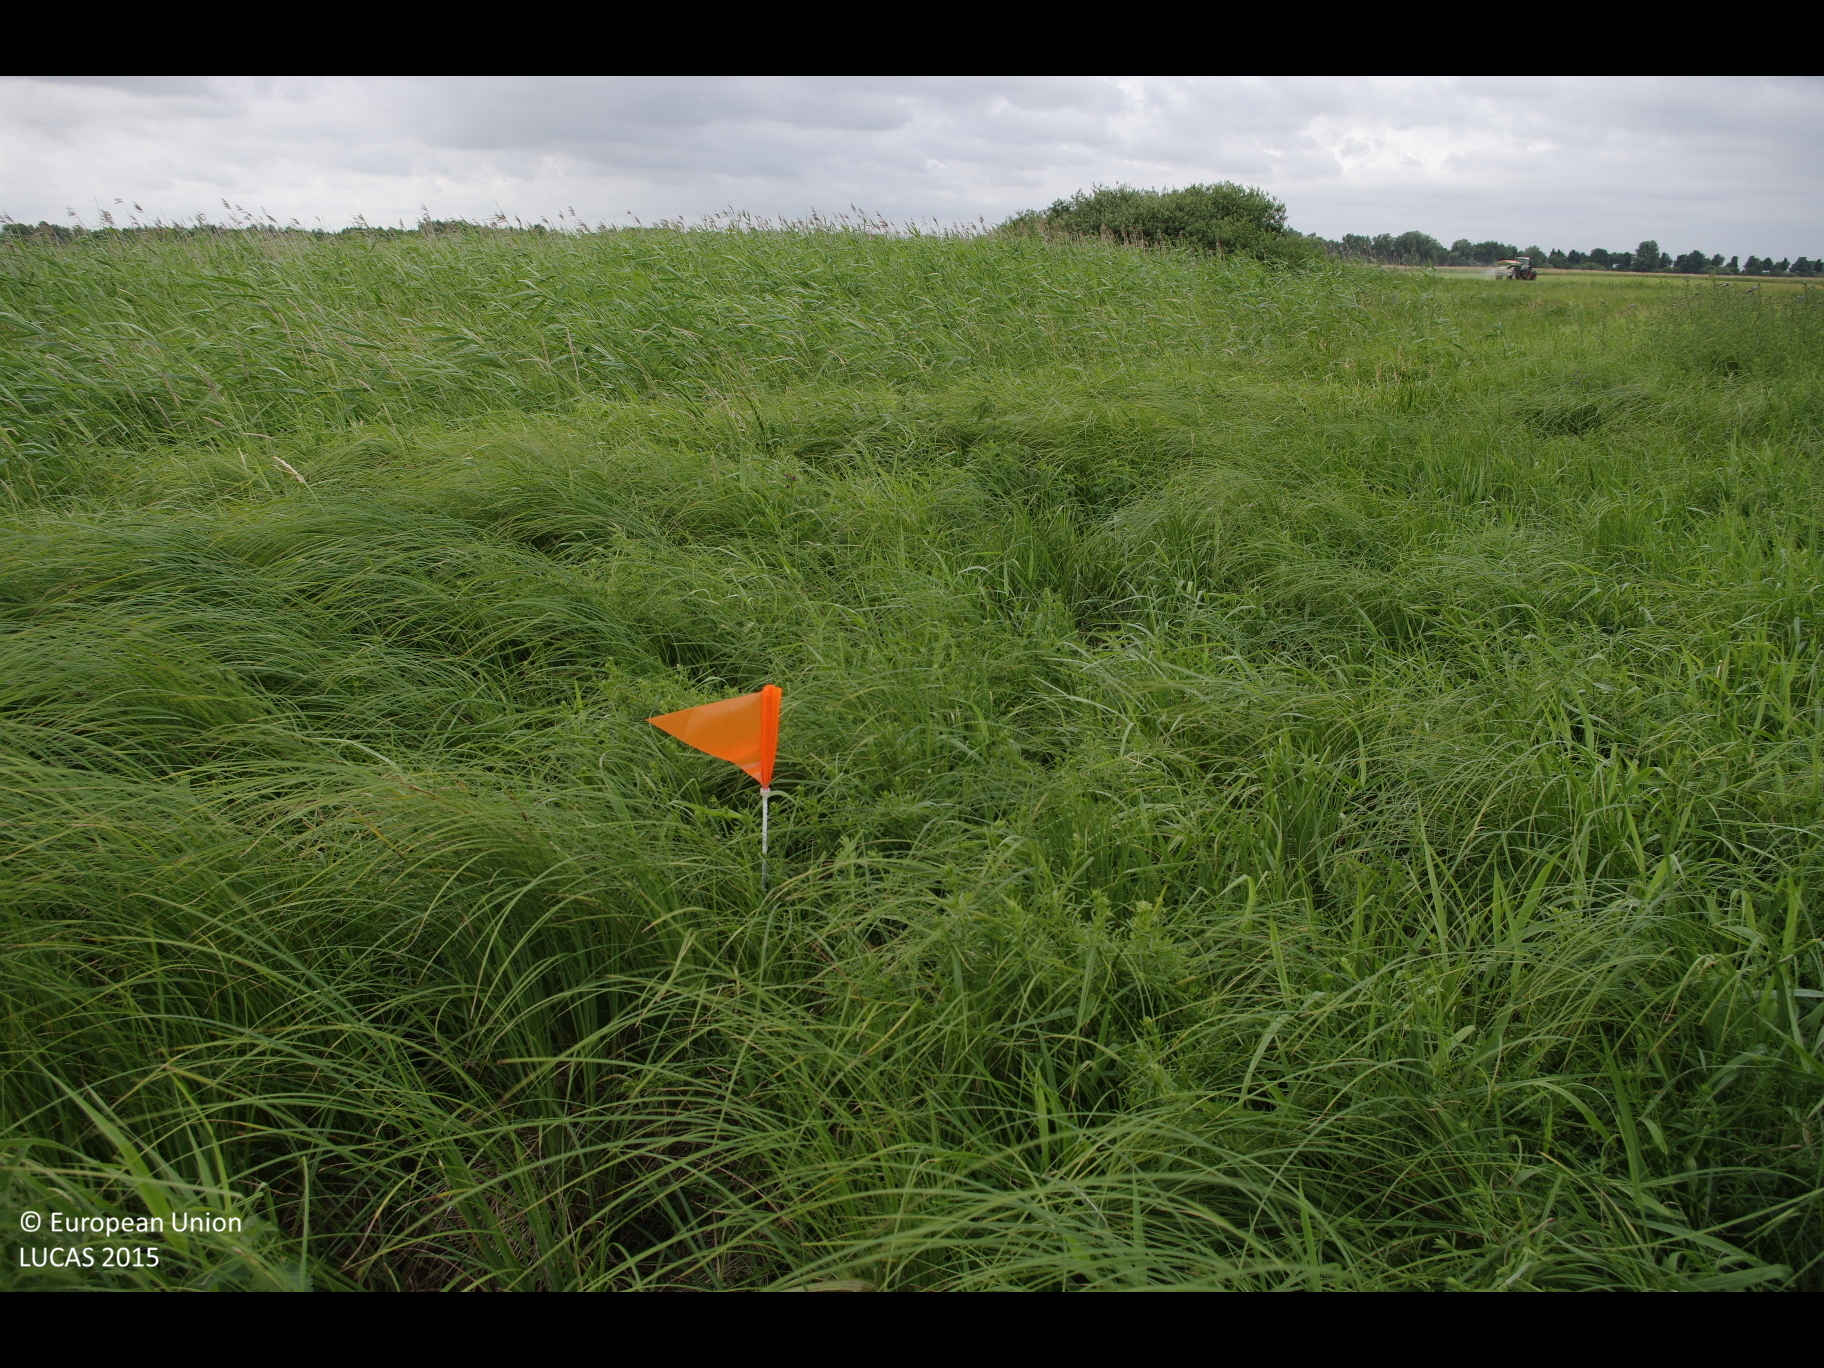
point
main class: Grassland
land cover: Grassland without tree/shrub cover
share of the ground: > 75 %
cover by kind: herbaceous plants 100 %
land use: Semi-natural and natural areas not in use
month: July
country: DE
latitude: 53.3824
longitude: 10.6161
